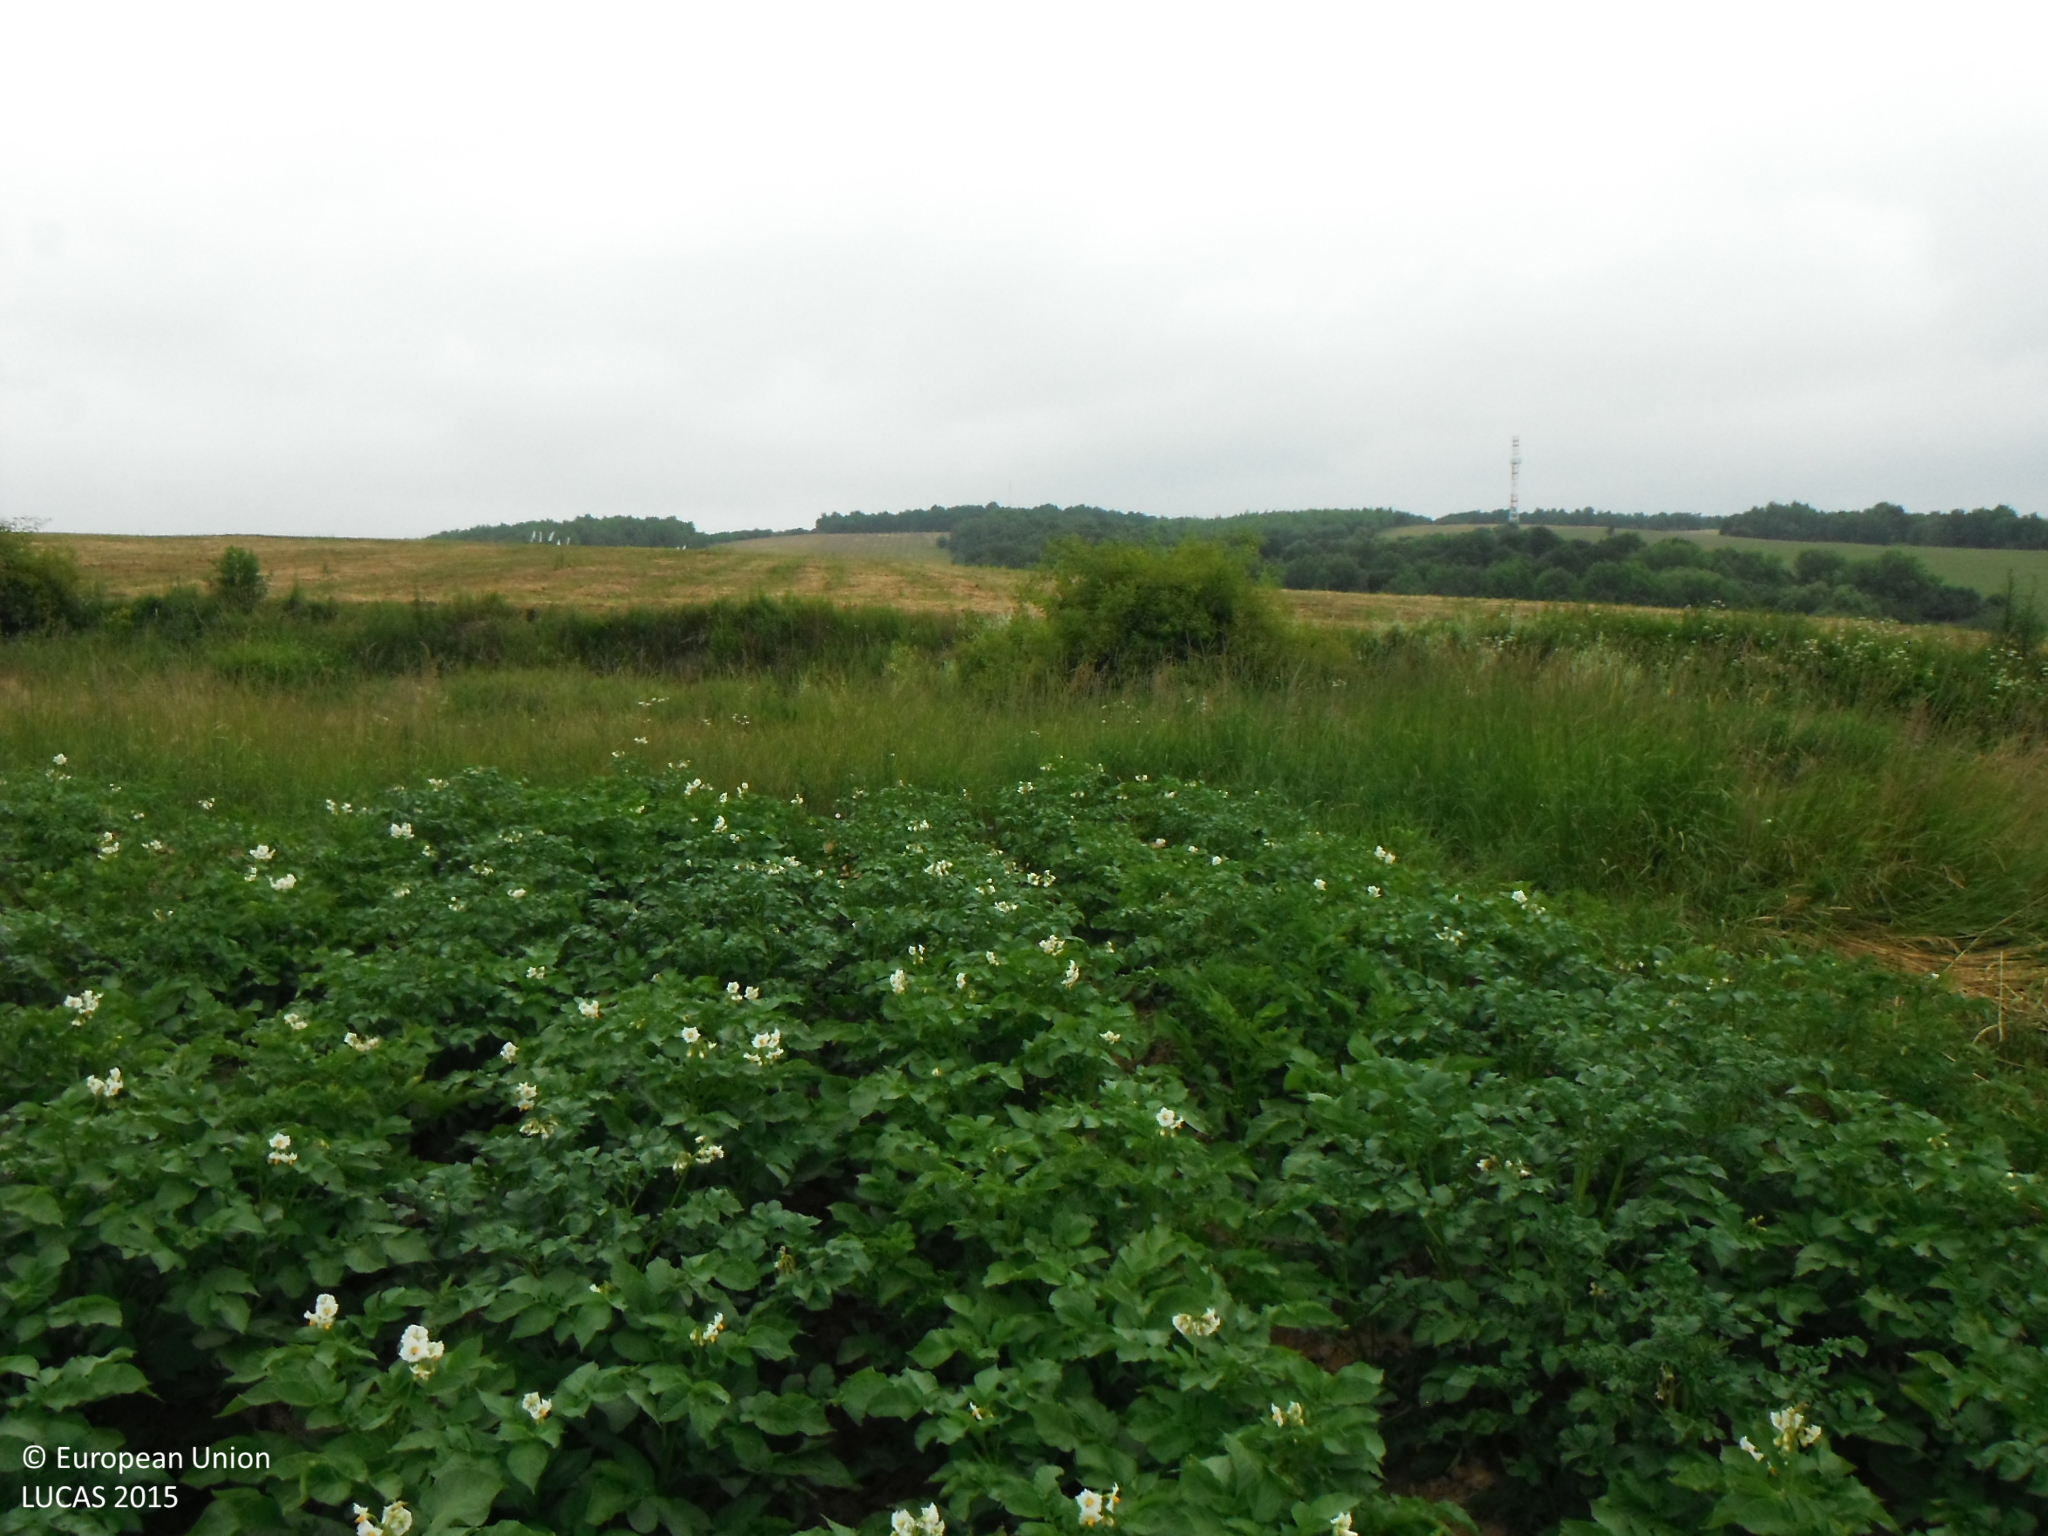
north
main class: Cropland
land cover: Potatoes
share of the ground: > 75 %
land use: Agriculture (excluding fallow land and kitchen gardens)
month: June
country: SK
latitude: 49.1883
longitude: 21.6171
